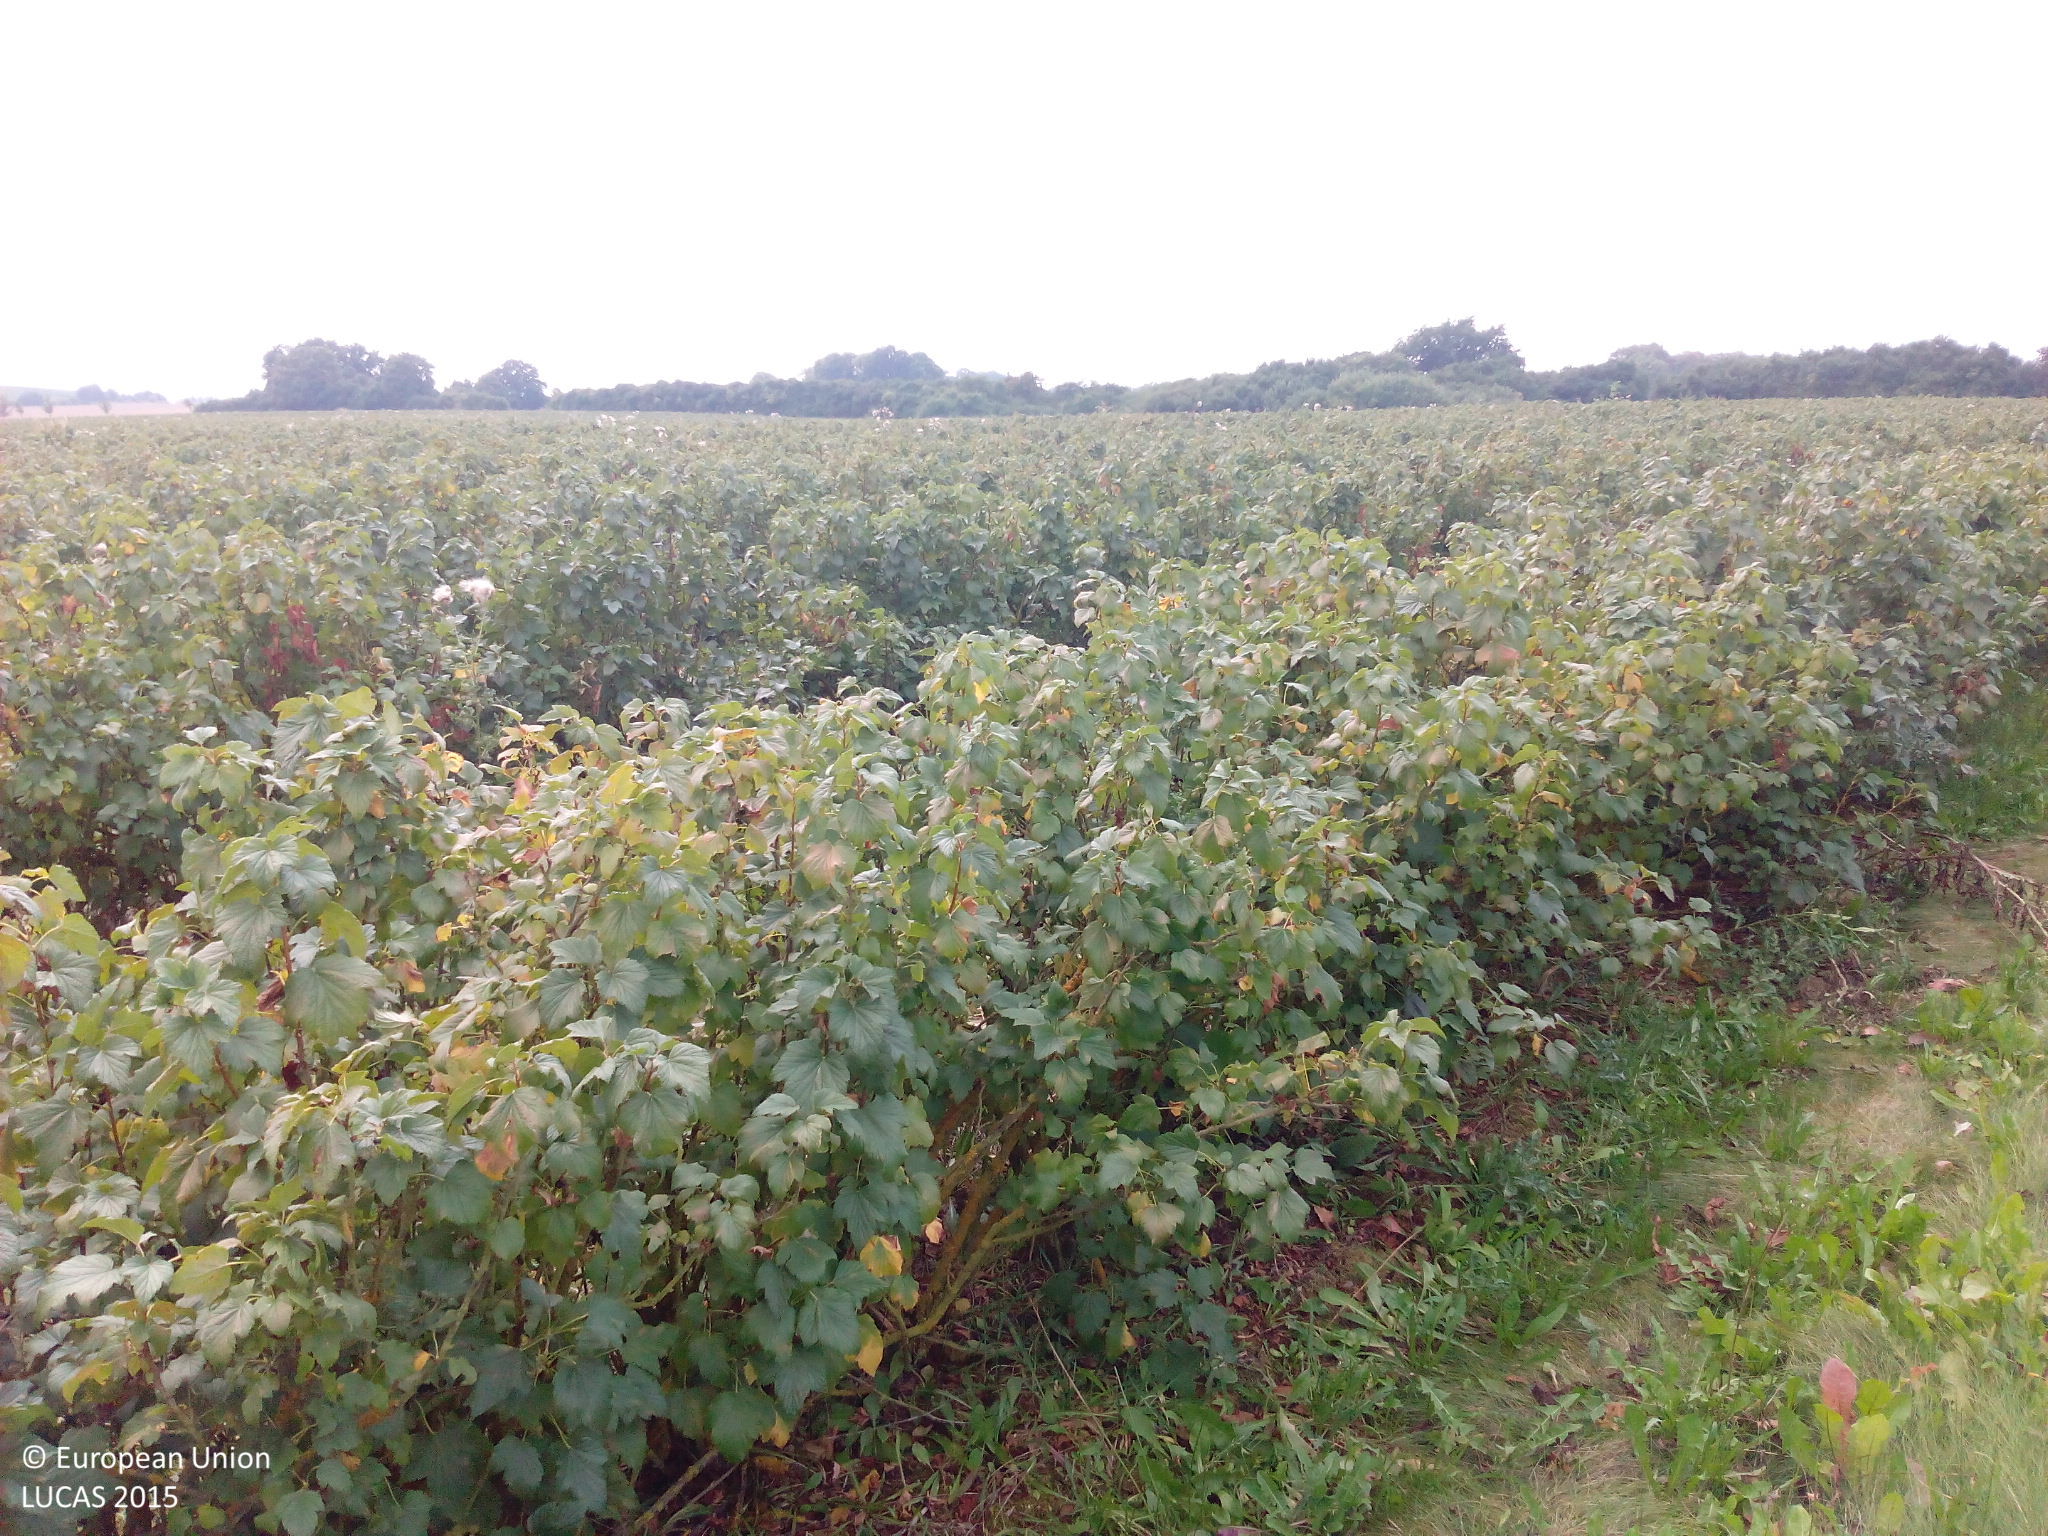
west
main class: Cropland
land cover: Other fruit trees and berries
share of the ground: > 75 %
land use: Agriculture (excluding fallow land and kitchen gardens)
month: August
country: DE
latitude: 53.7518
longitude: 12.5925
